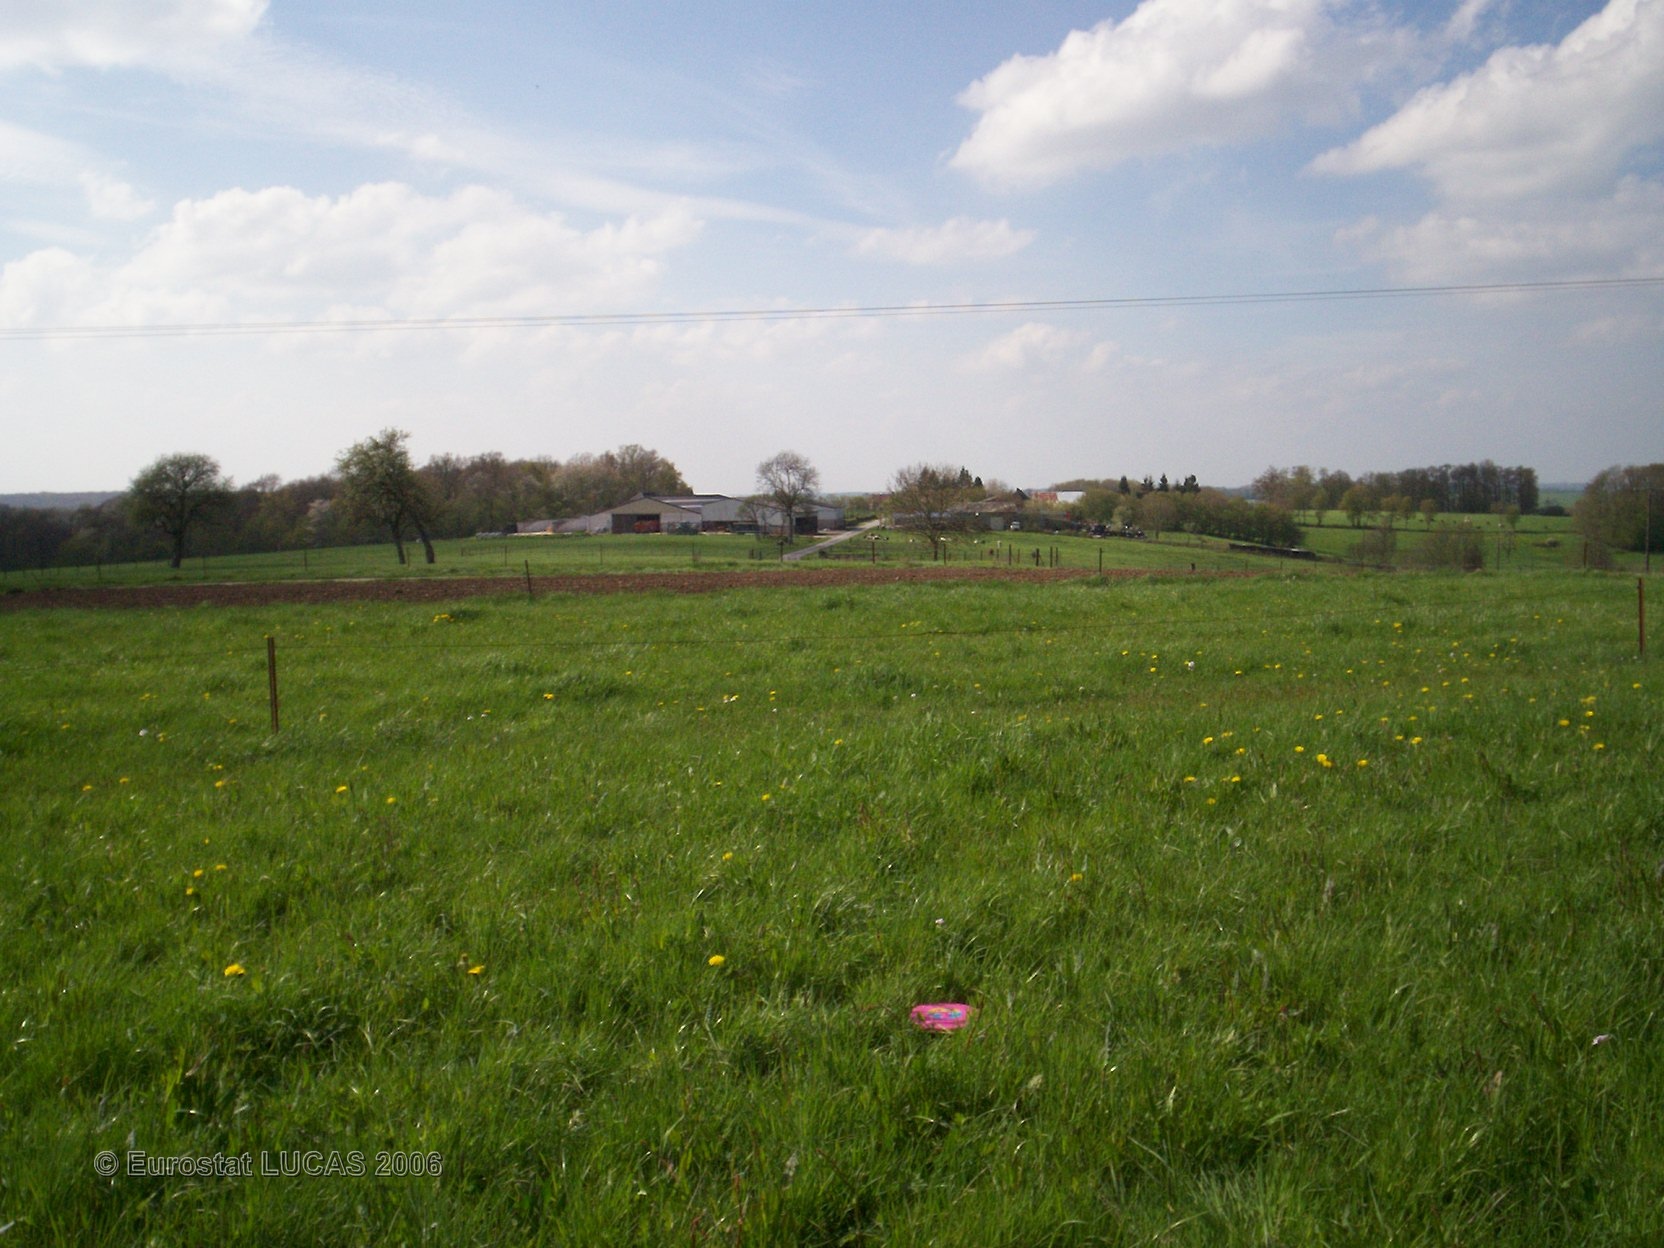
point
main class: Grassland
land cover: Grassland without tree/shrub cover
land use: Agriculture (excluding fallow land and kitchen gardens)
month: May
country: FR
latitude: 49.7886
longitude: 4.2866
